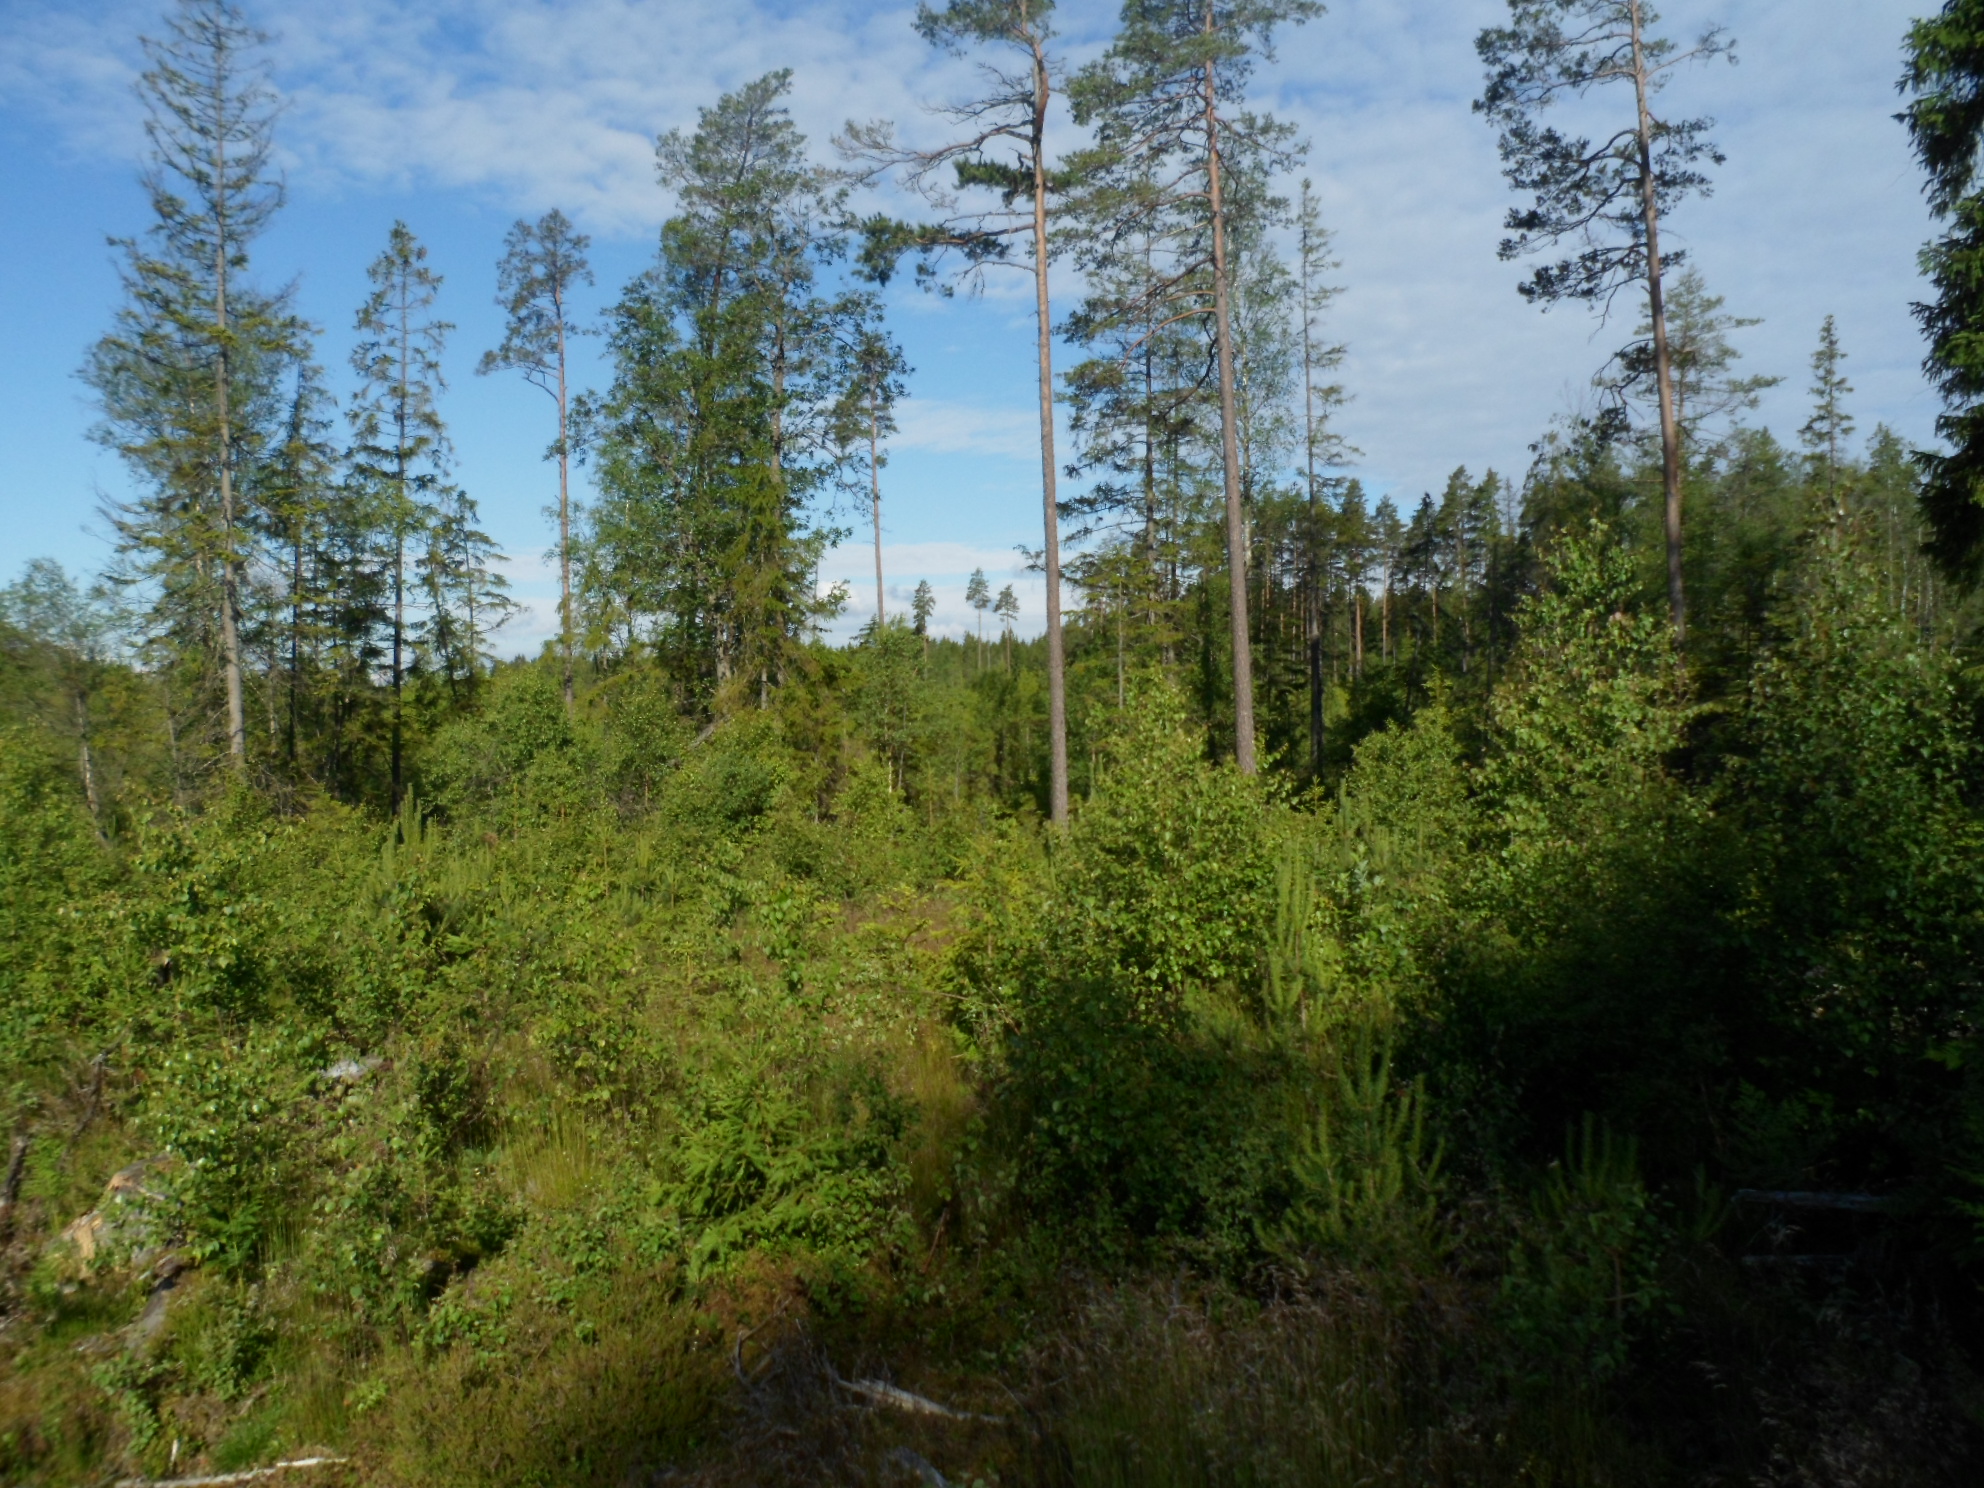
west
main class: Woodland
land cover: Pine dominated mixed woodland
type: boreal forest
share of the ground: 50 - 75 %
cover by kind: broadleaved forest trees 35 %, coniferous forest trees 25 %, herbaceous plants 25 %, shrubs 10 %, lichens and mosses 5 %
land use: Forestry
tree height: < 5 m
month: June
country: SE
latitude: 57.0617
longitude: 15.4890
